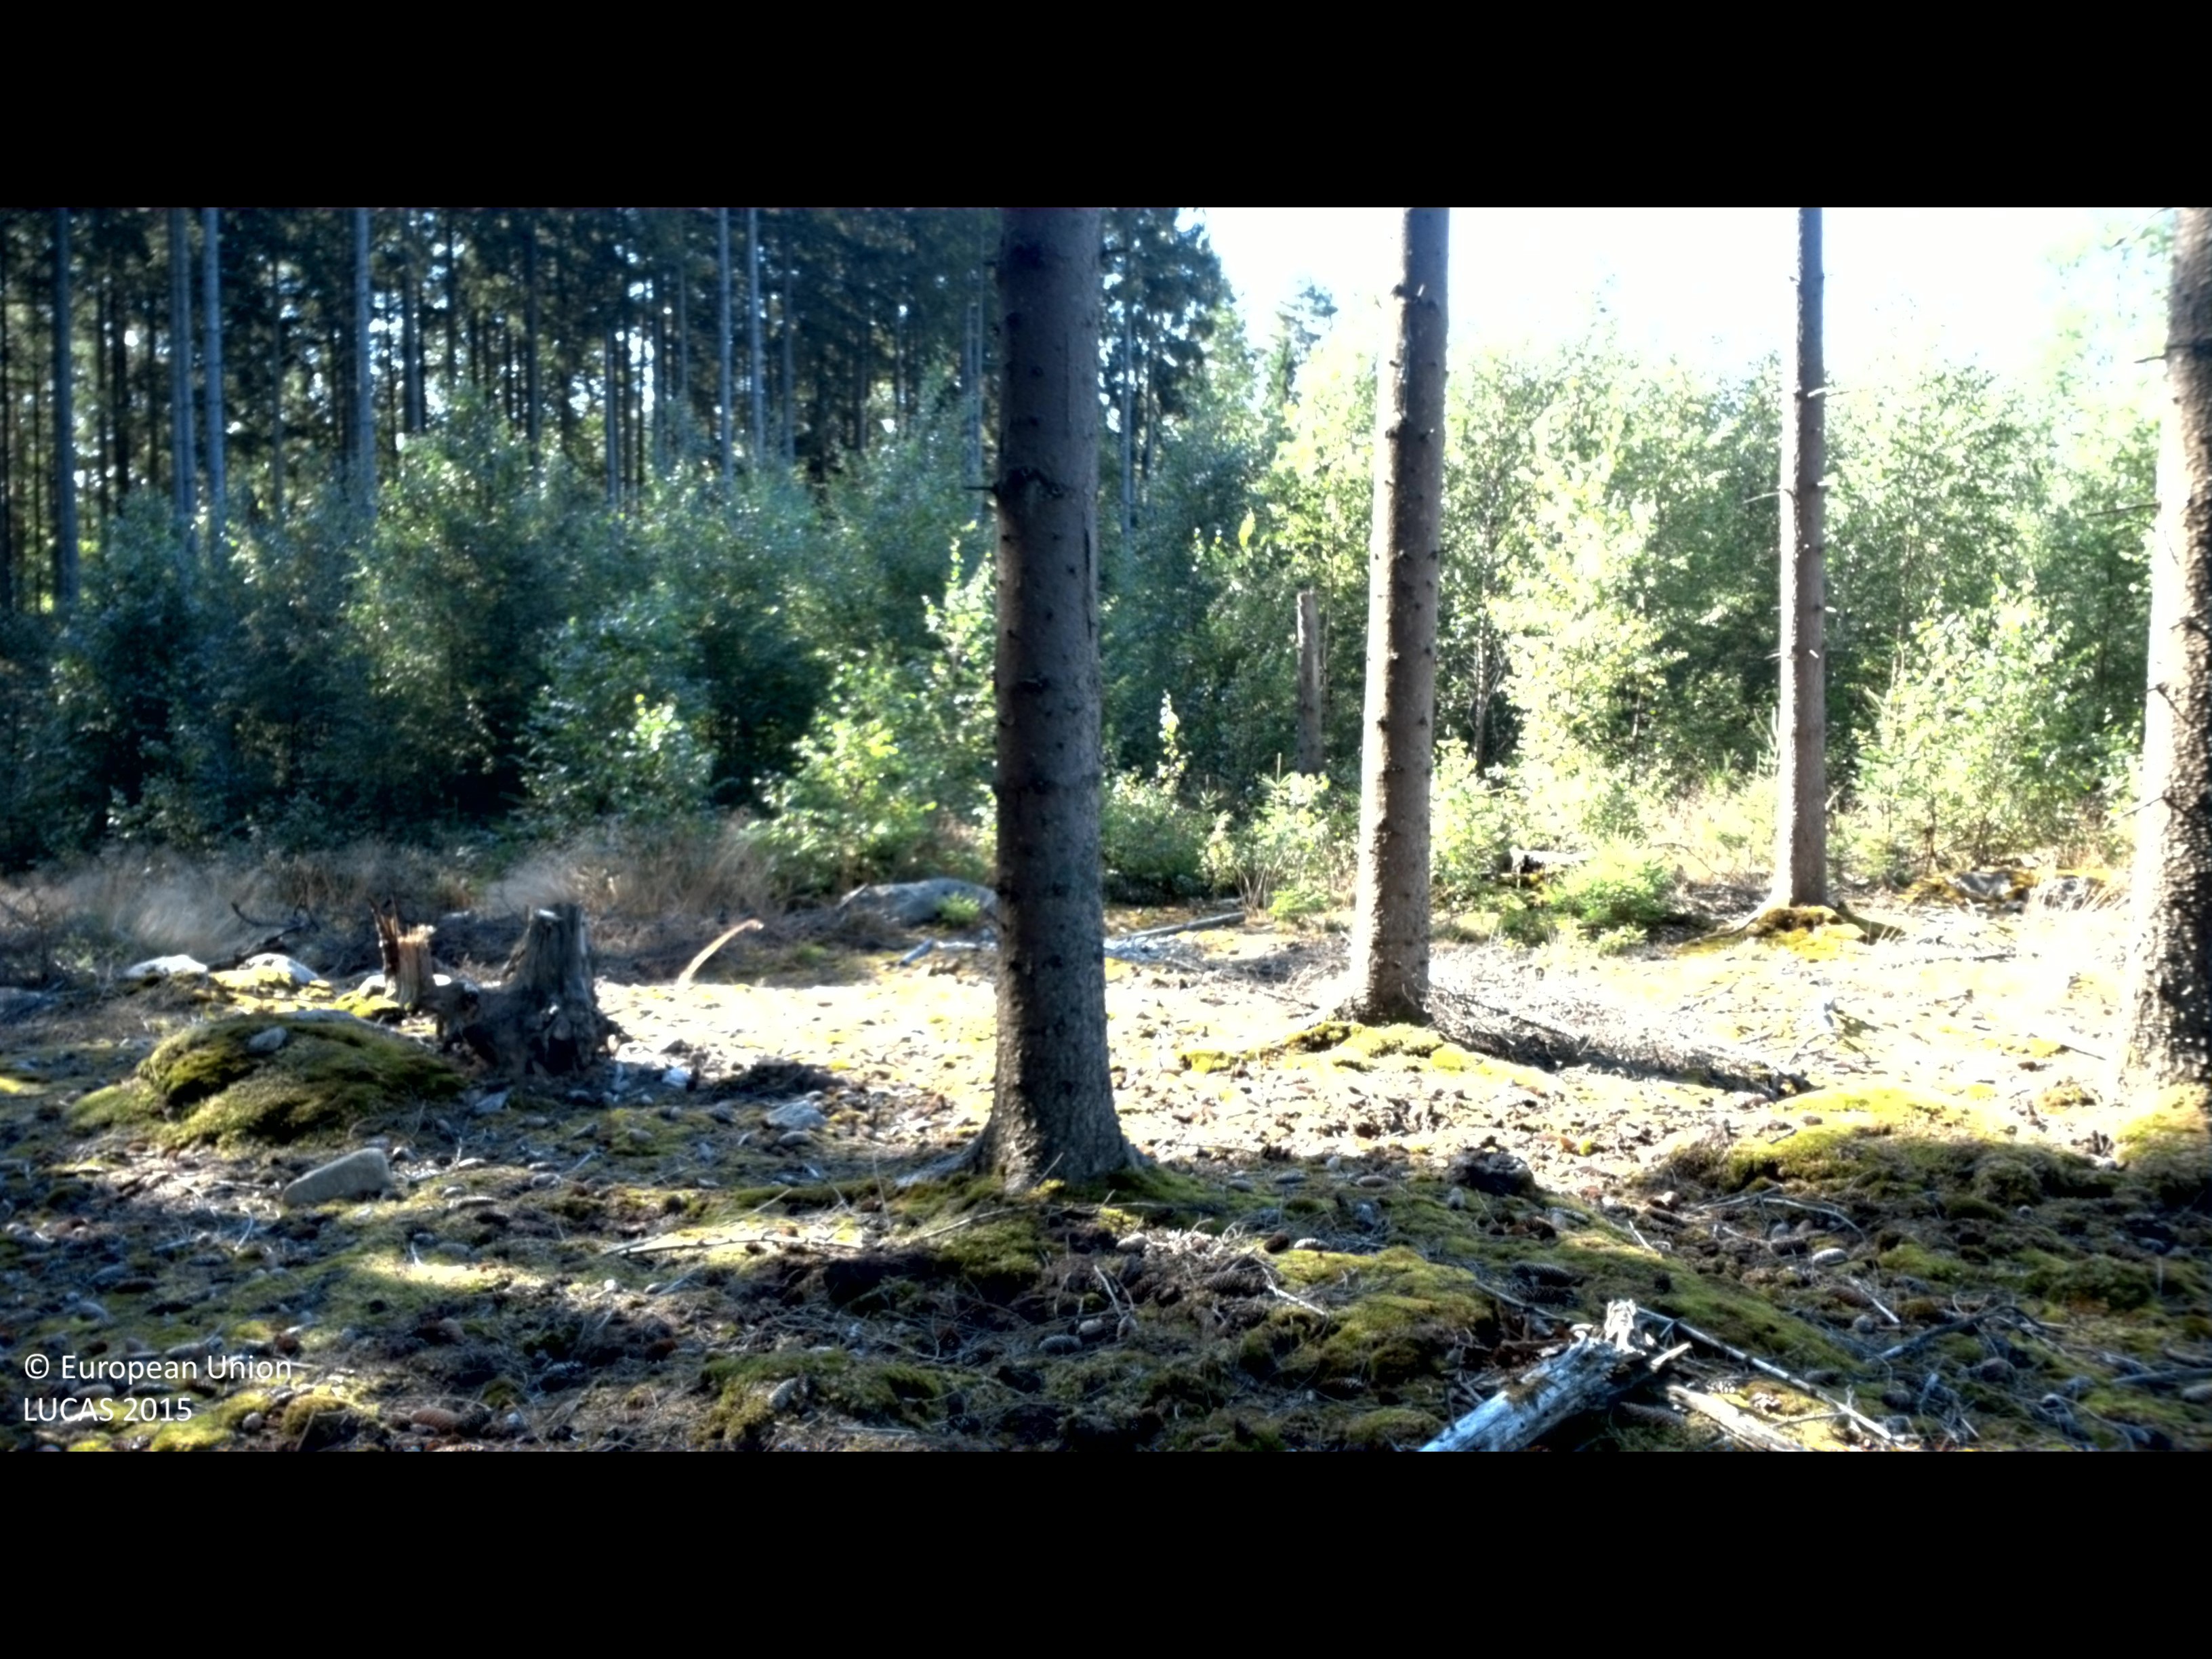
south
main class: Woodland
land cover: Spruce dominated coniferous woodland
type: boreal forest
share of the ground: 50 - 75 %
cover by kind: coniferous forest trees 65 %, lichens and mosses 30 %, consolidated bare surface 5 %
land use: Forestry
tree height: > 5 m
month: August
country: SE
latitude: 56.3033
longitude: 14.6040
